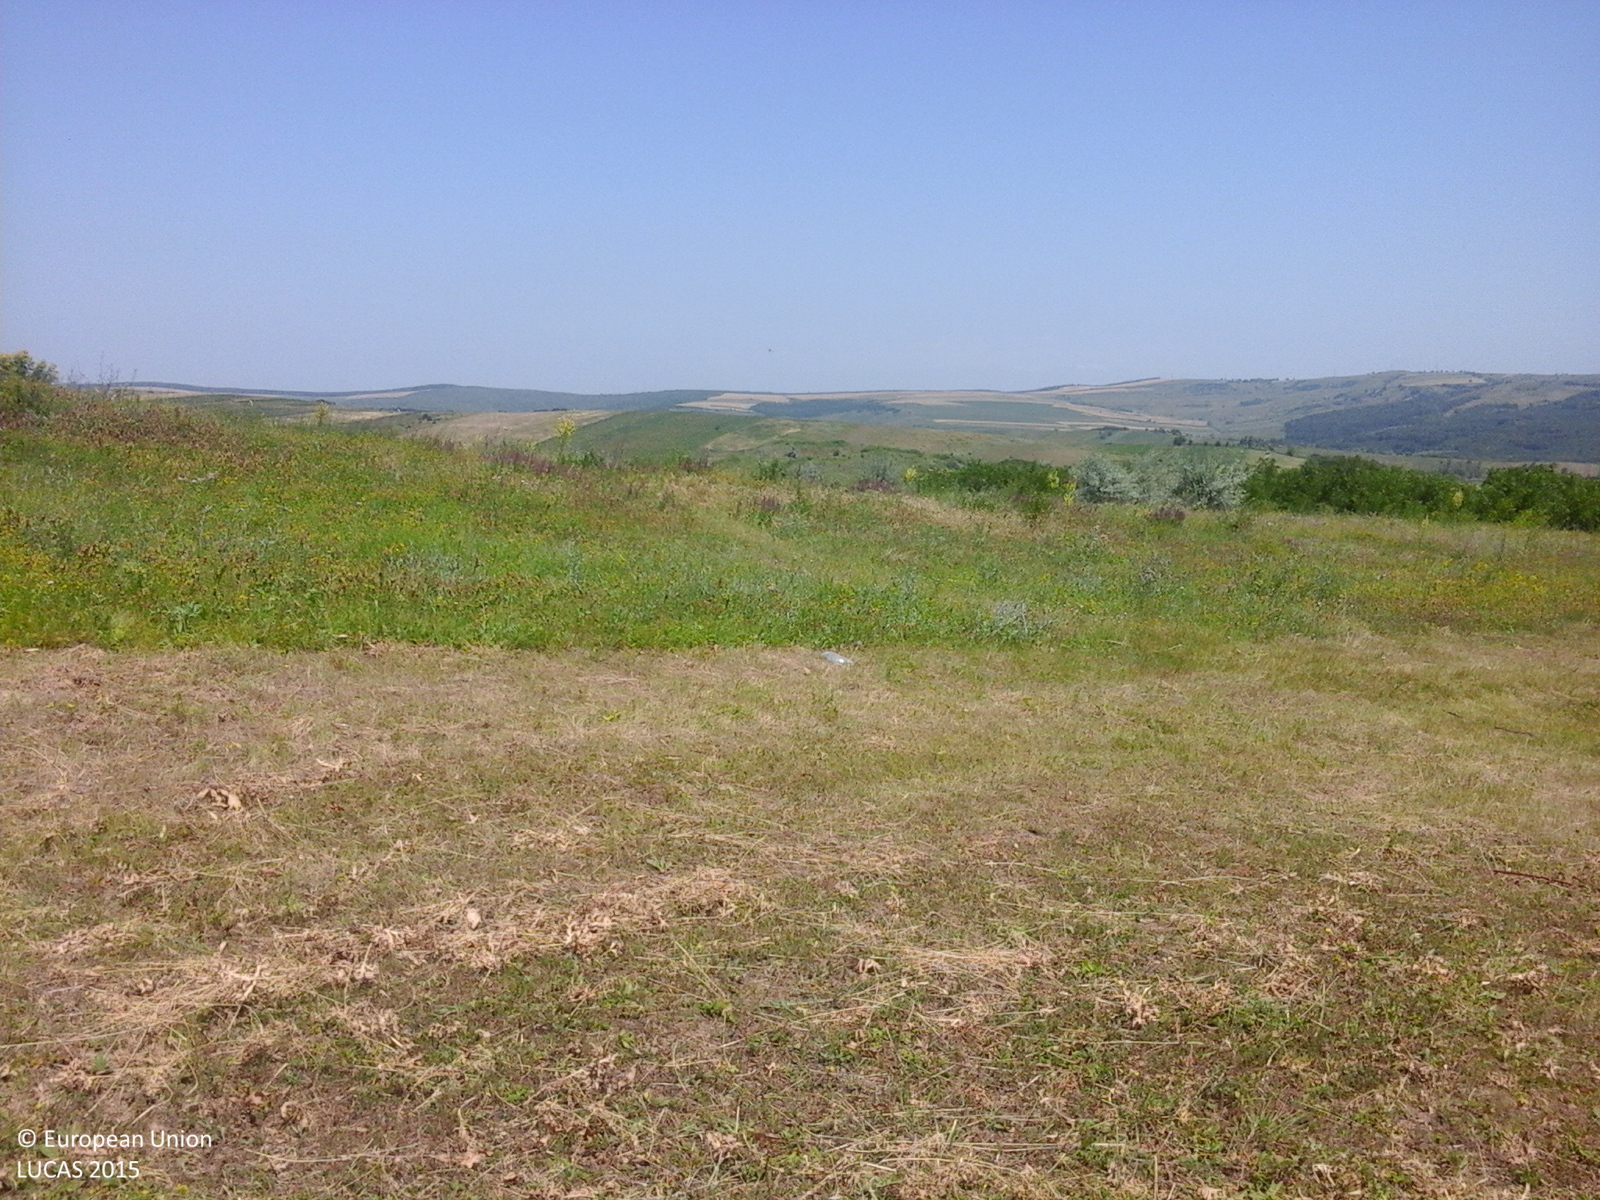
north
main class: Grassland
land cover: Grassland with sparse tree/shrub cover
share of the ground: > 75 %
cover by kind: herbaceous plants 90 %, broadleaved forest trees 5 %, shrubs 5 %
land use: Agriculture (excluding fallow land and kitchen gardens)
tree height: < 5 m
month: June
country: RO
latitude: 46.7429
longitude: 27.4536
